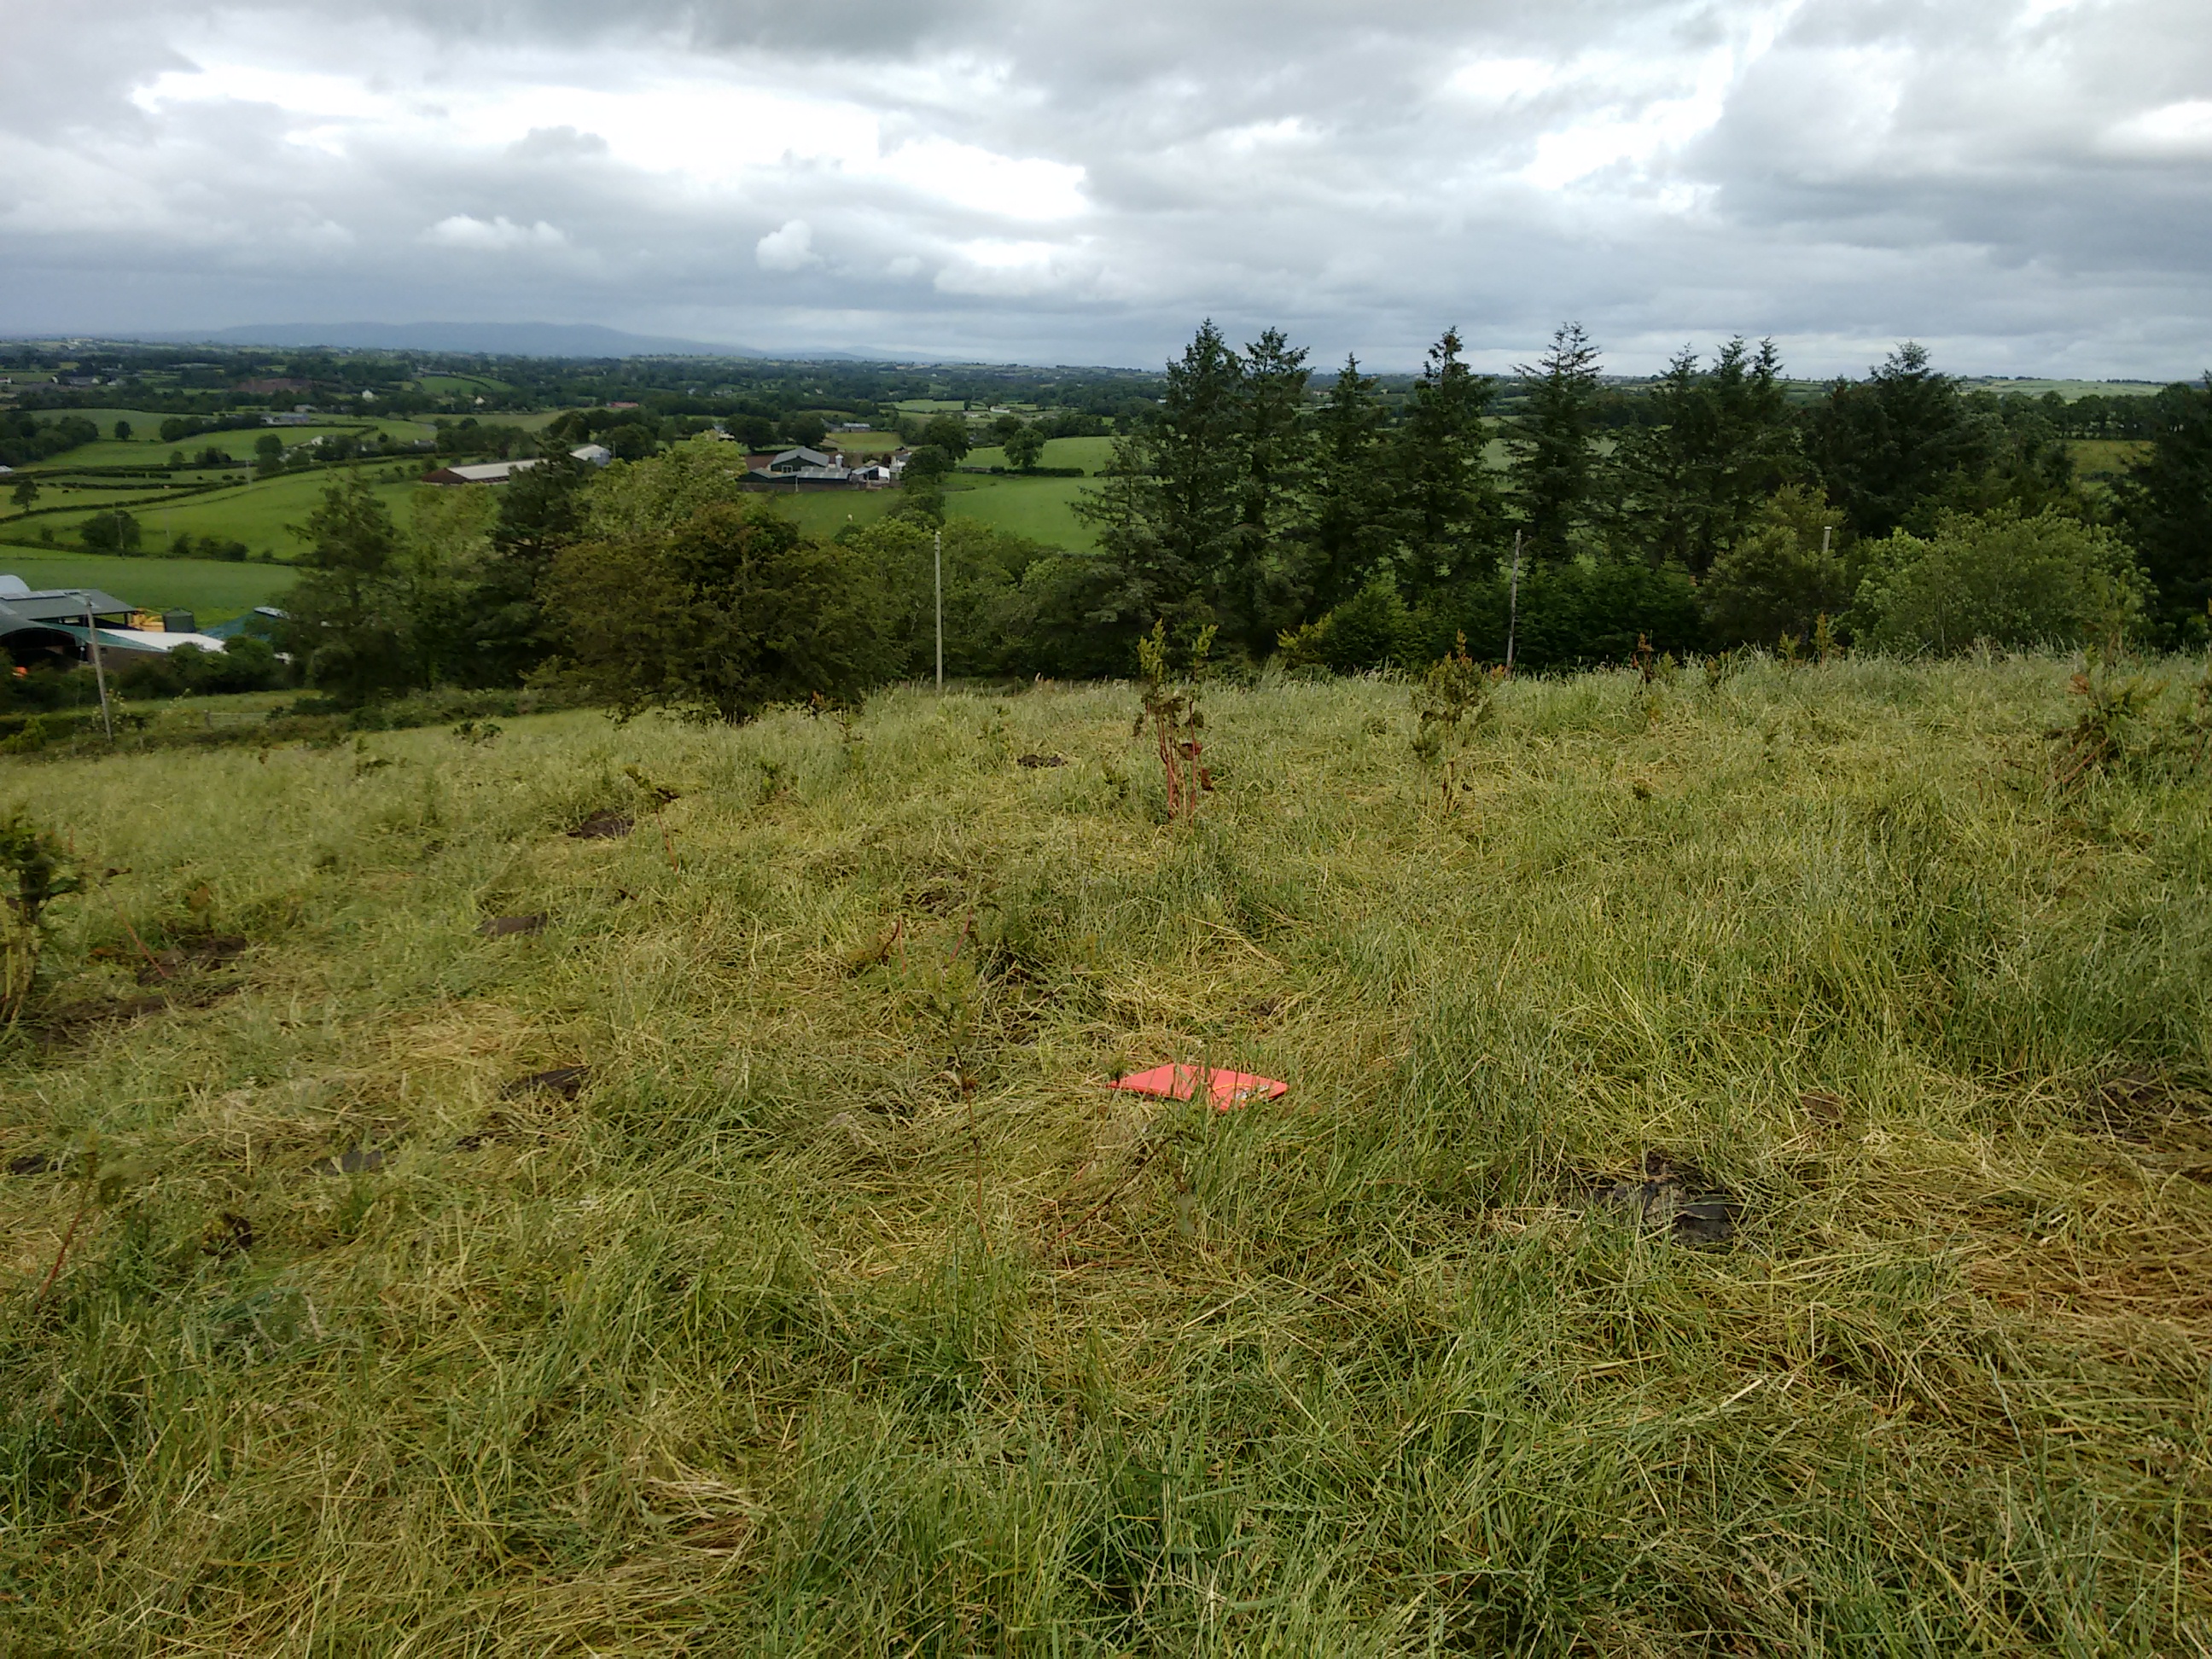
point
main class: Grassland
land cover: Grassland without tree/shrub cover
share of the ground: > 75 %
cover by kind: herbaceous plants 100 %
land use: Agriculture (excluding fallow land and kitchen gardens)
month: July
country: GB
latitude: 54.4608
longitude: -7.1922
